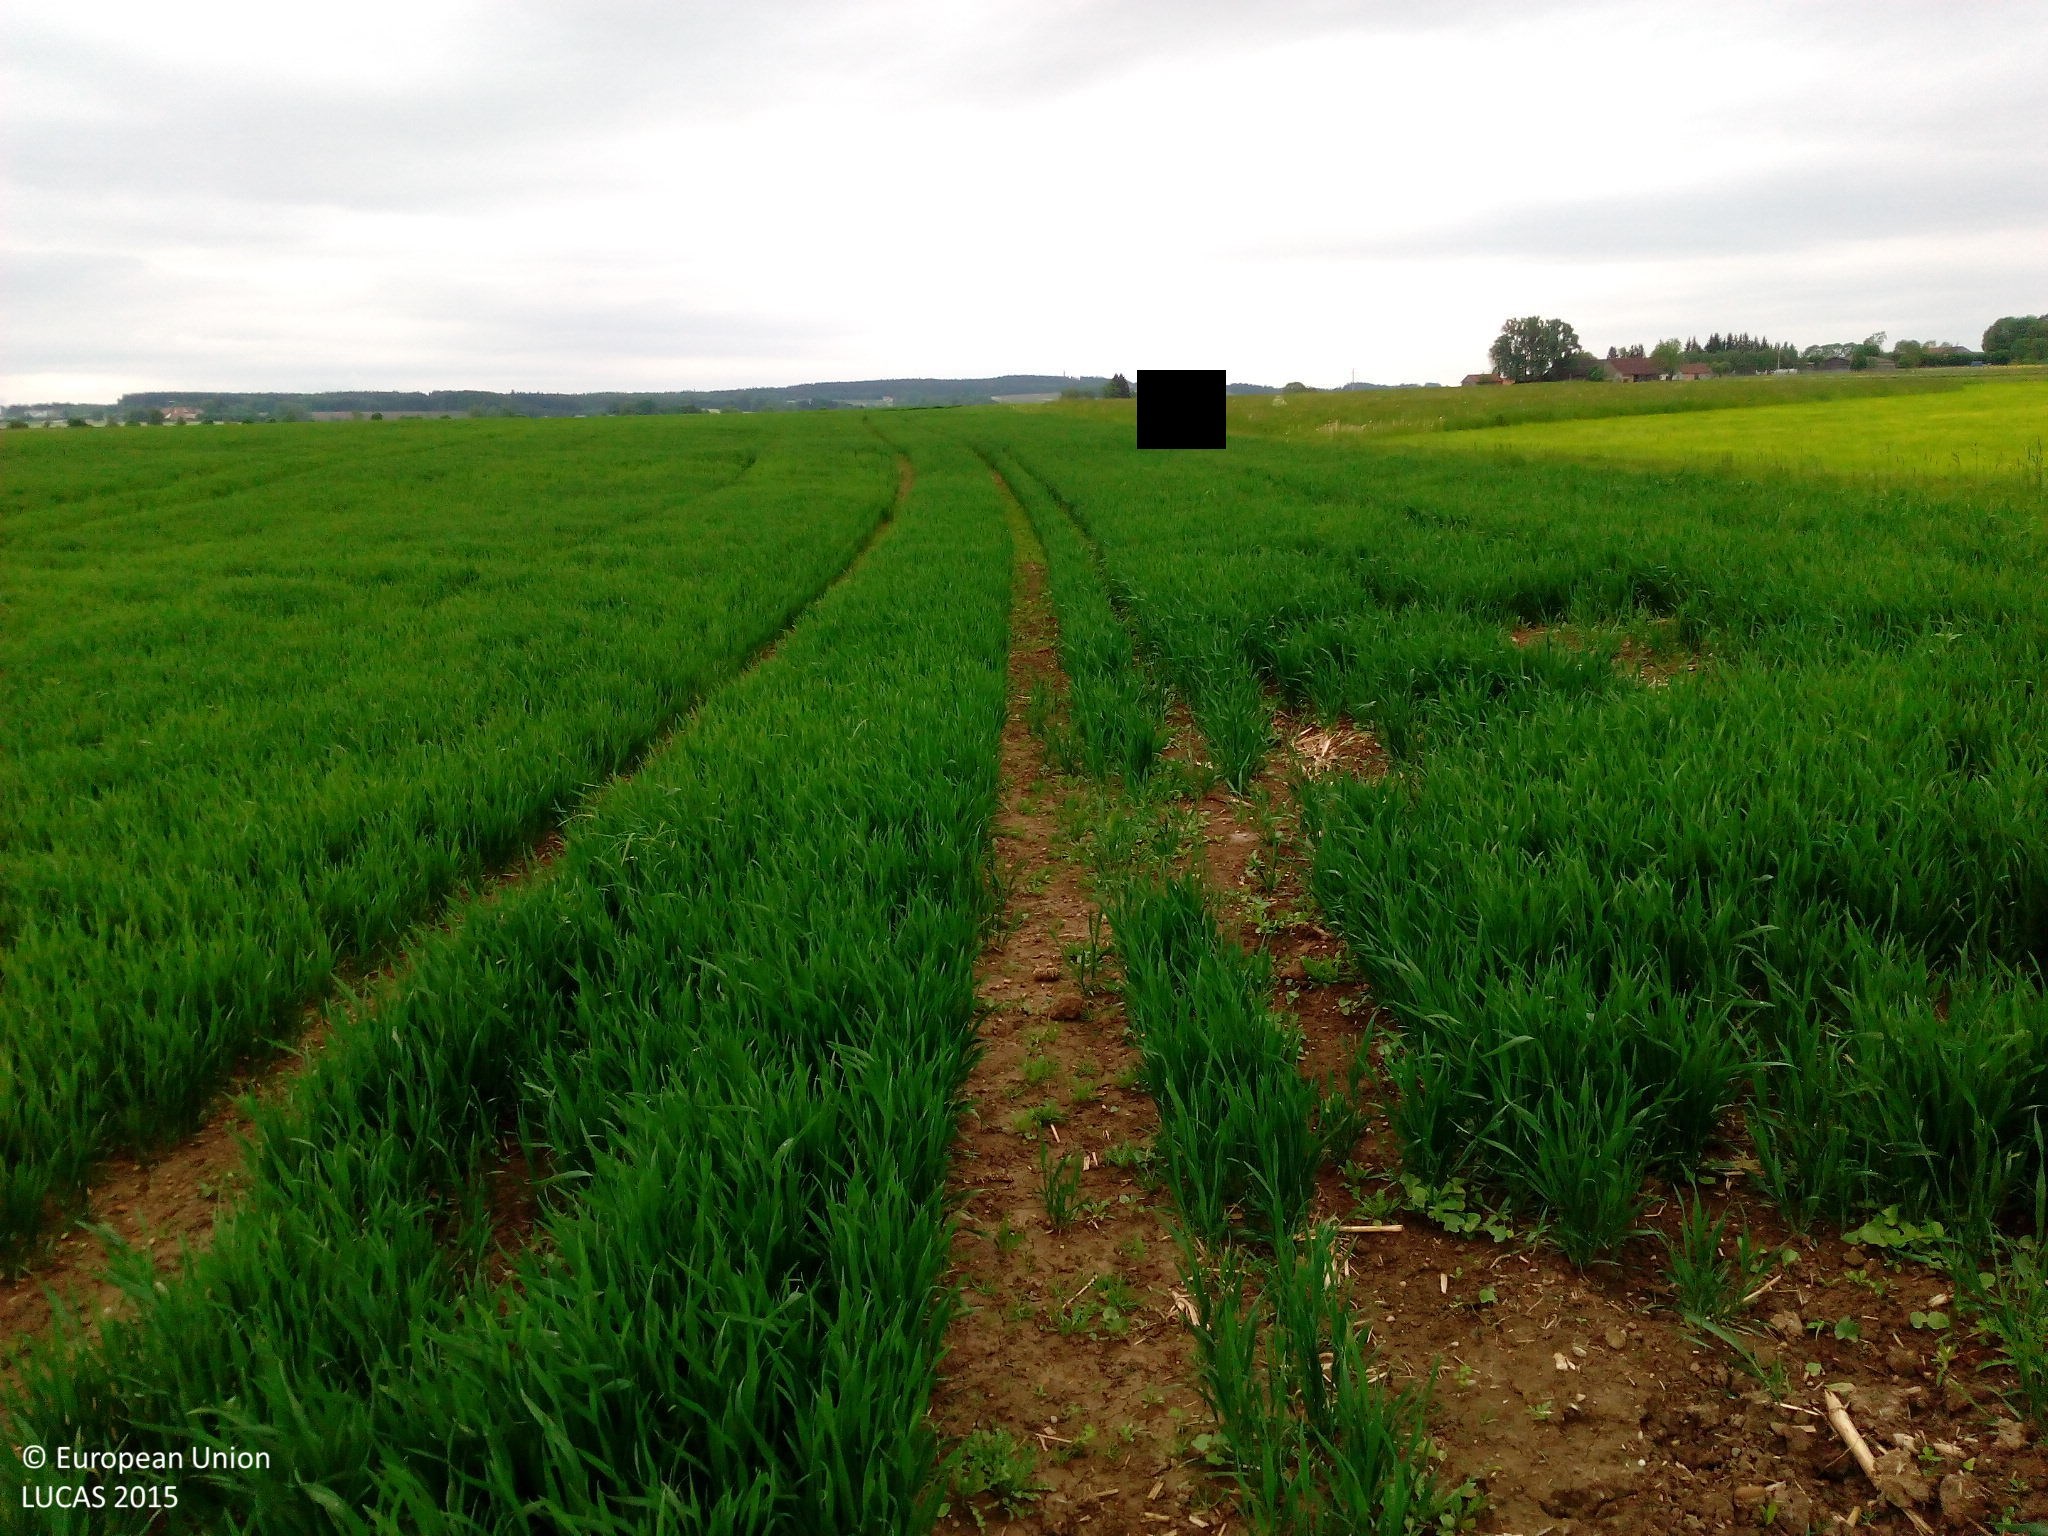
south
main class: Cropland
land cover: Common wheat
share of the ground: > 75 %
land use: Agriculture (excluding fallow land and kitchen gardens)
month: May
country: DE
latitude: 47.9536
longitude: 9.9331
